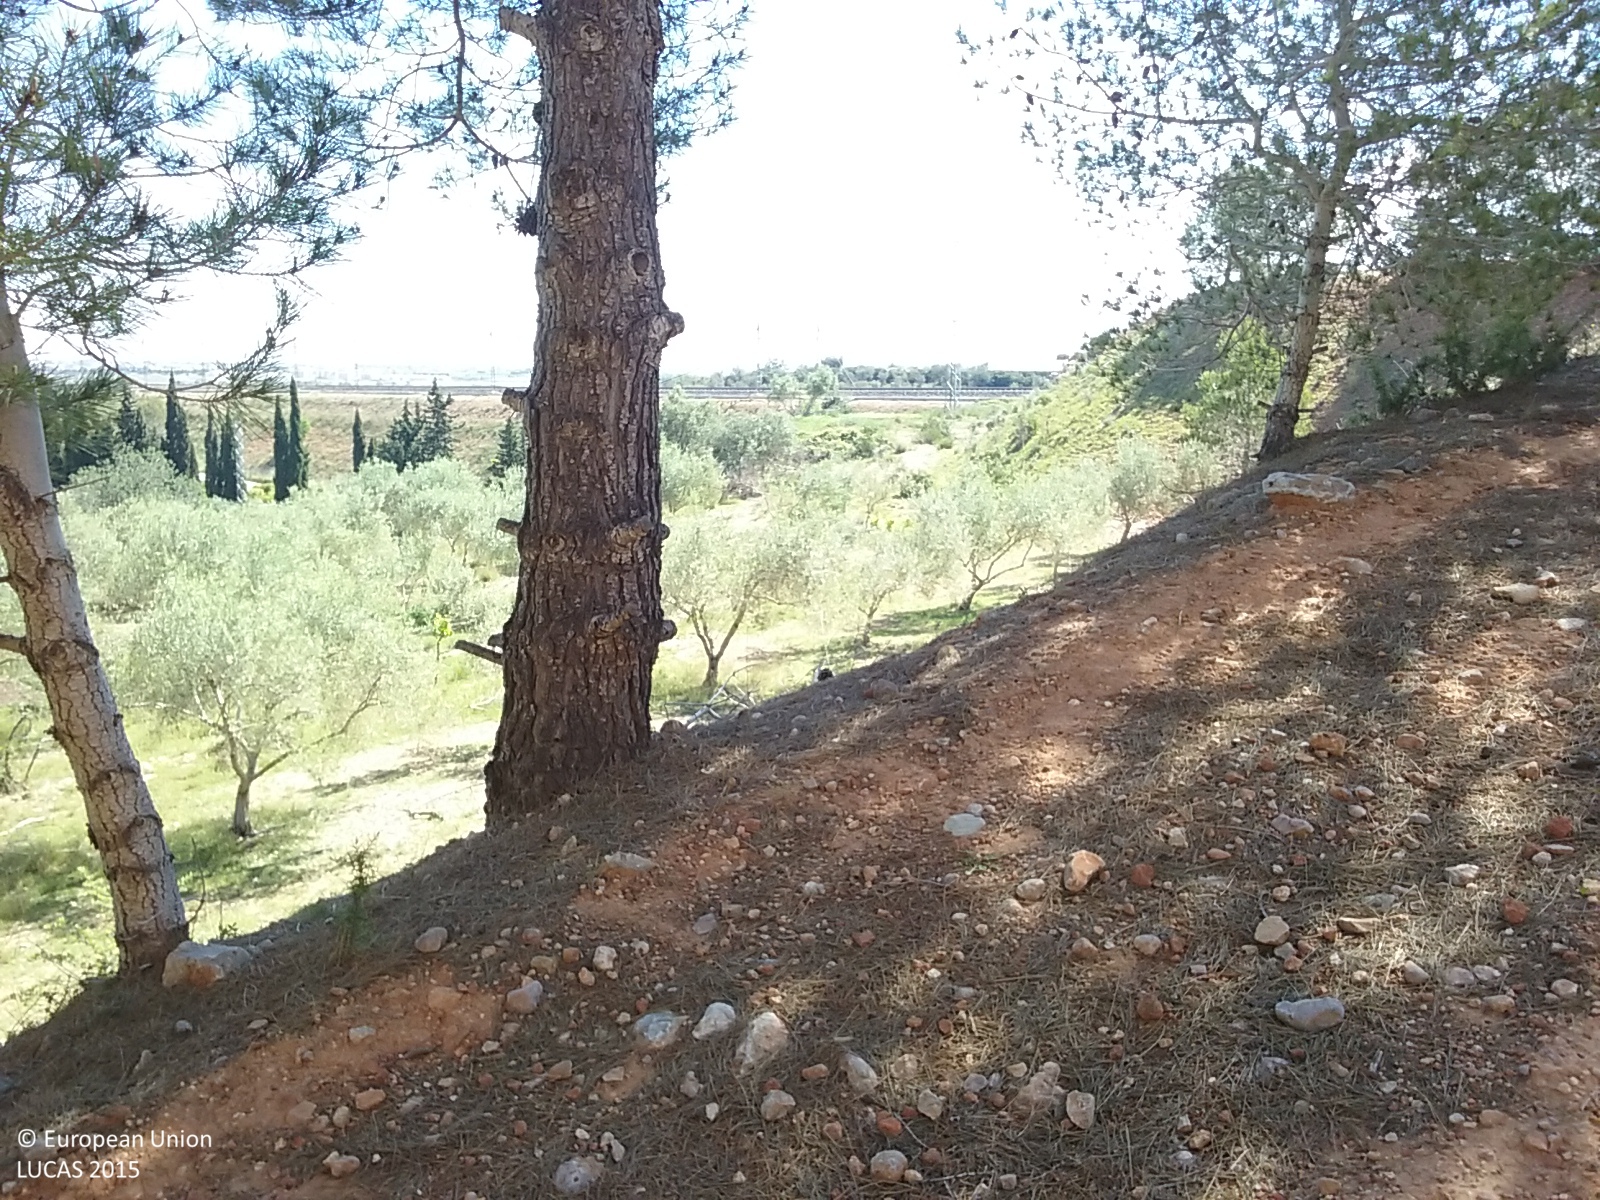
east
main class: Cropland
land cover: Permanent crops (only in case pi)
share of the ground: 25 - 50 %
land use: Agriculture (excluding fallow land and kitchen gardens)
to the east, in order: Permanent crops (only in case pi); Artificial constructions in urban areas; Permanent crops (only in case pi); Fences; Dry stone walls; Shrubland with sparse tree cover; Tracks; Groves; Shrubland with sparse tree cover; Olive groves; Dry stone walls; Shrubland with sparse tree cover; Electric lines; Shrubland with sparse tree cover; Fences; Grassland without tree/shrub cover; Electric lines; Railways; Grassland without tree/shrub cover; Pine dominated coniferous woodland
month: April
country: ES
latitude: 40.7212
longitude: 0.5593
